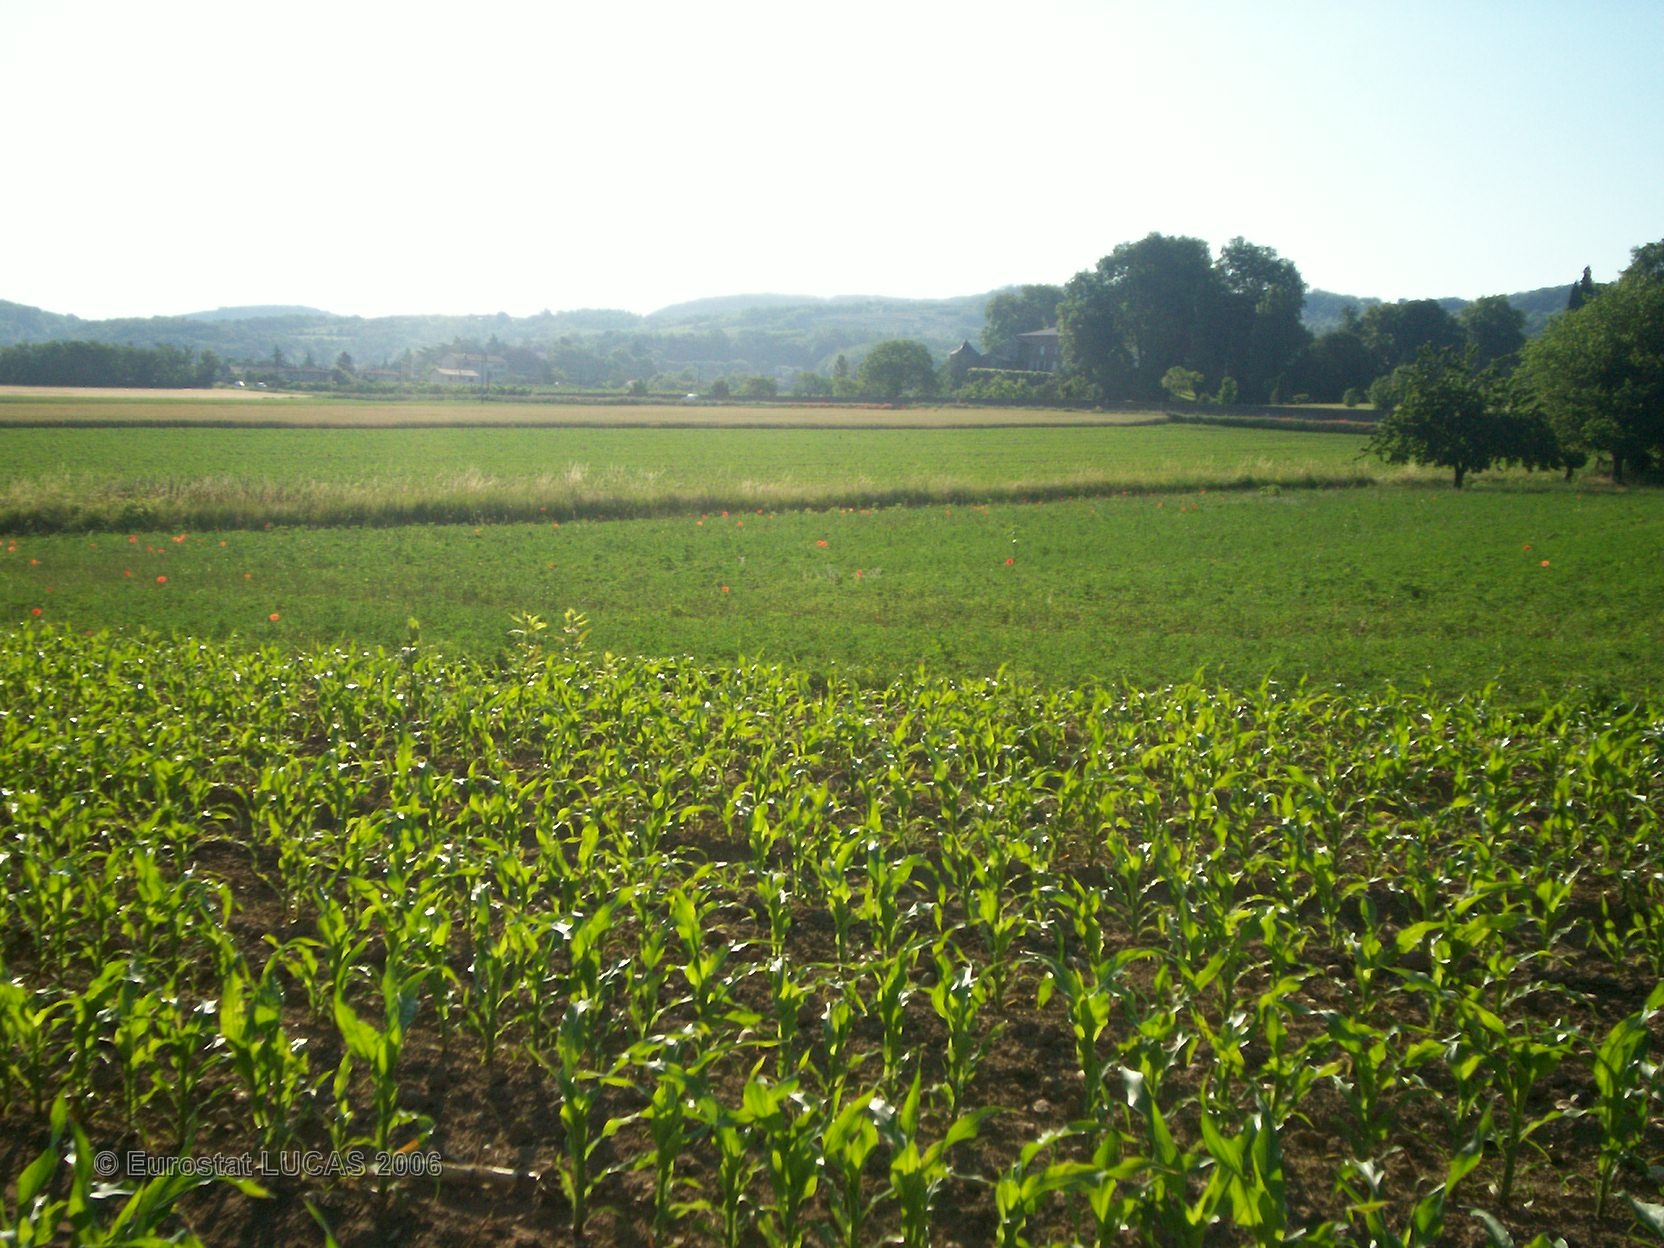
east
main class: Cropland
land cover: Maize
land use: Agriculture (excluding fallow land and kitchen gardens)
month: June
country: FR
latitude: 45.2149
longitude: 4.8224
